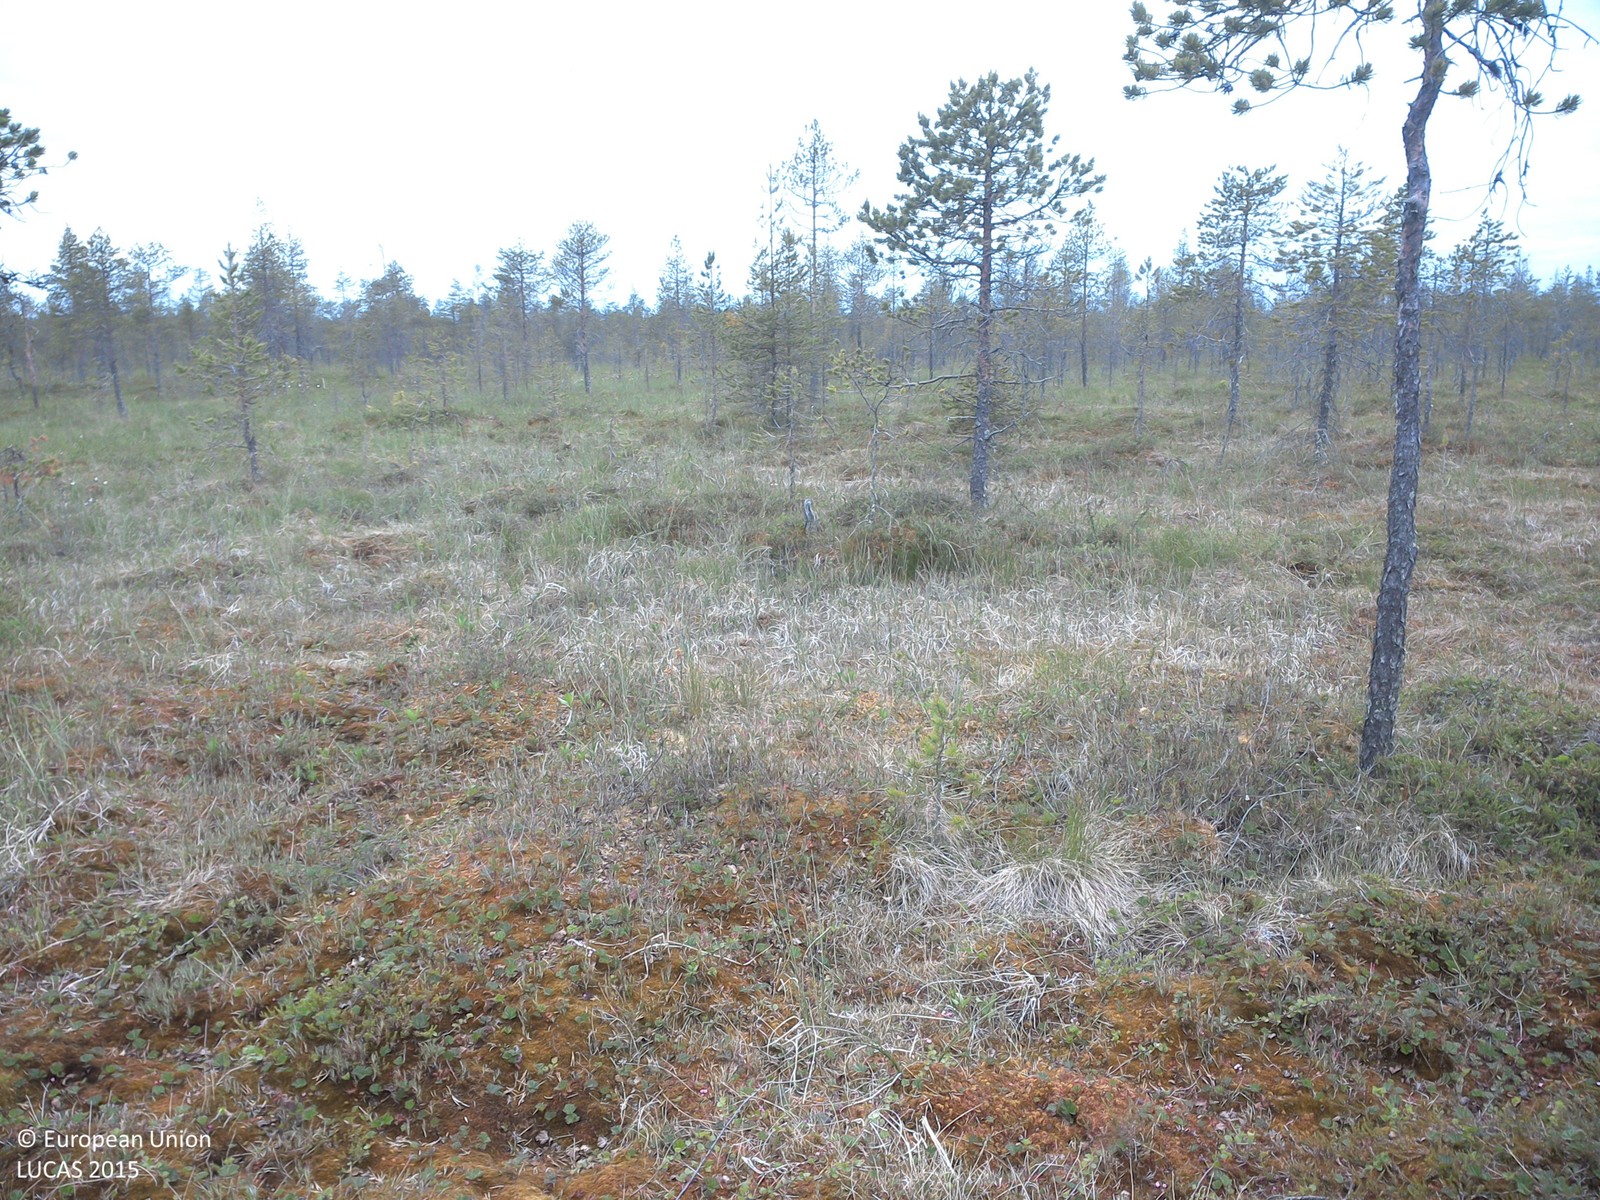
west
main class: Woodland
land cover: Pine dominated coniferous woodland
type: boreal forest
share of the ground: 10 - 25 %
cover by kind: lichens and mosses 45 %, herbaceous plants 25 %, shrubs 20 %, coniferous forest trees 10 %
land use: Amenities, museums, leisure
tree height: < 5 m
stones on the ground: < 10 %
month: July
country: SE
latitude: 66.8755
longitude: 23.0012
